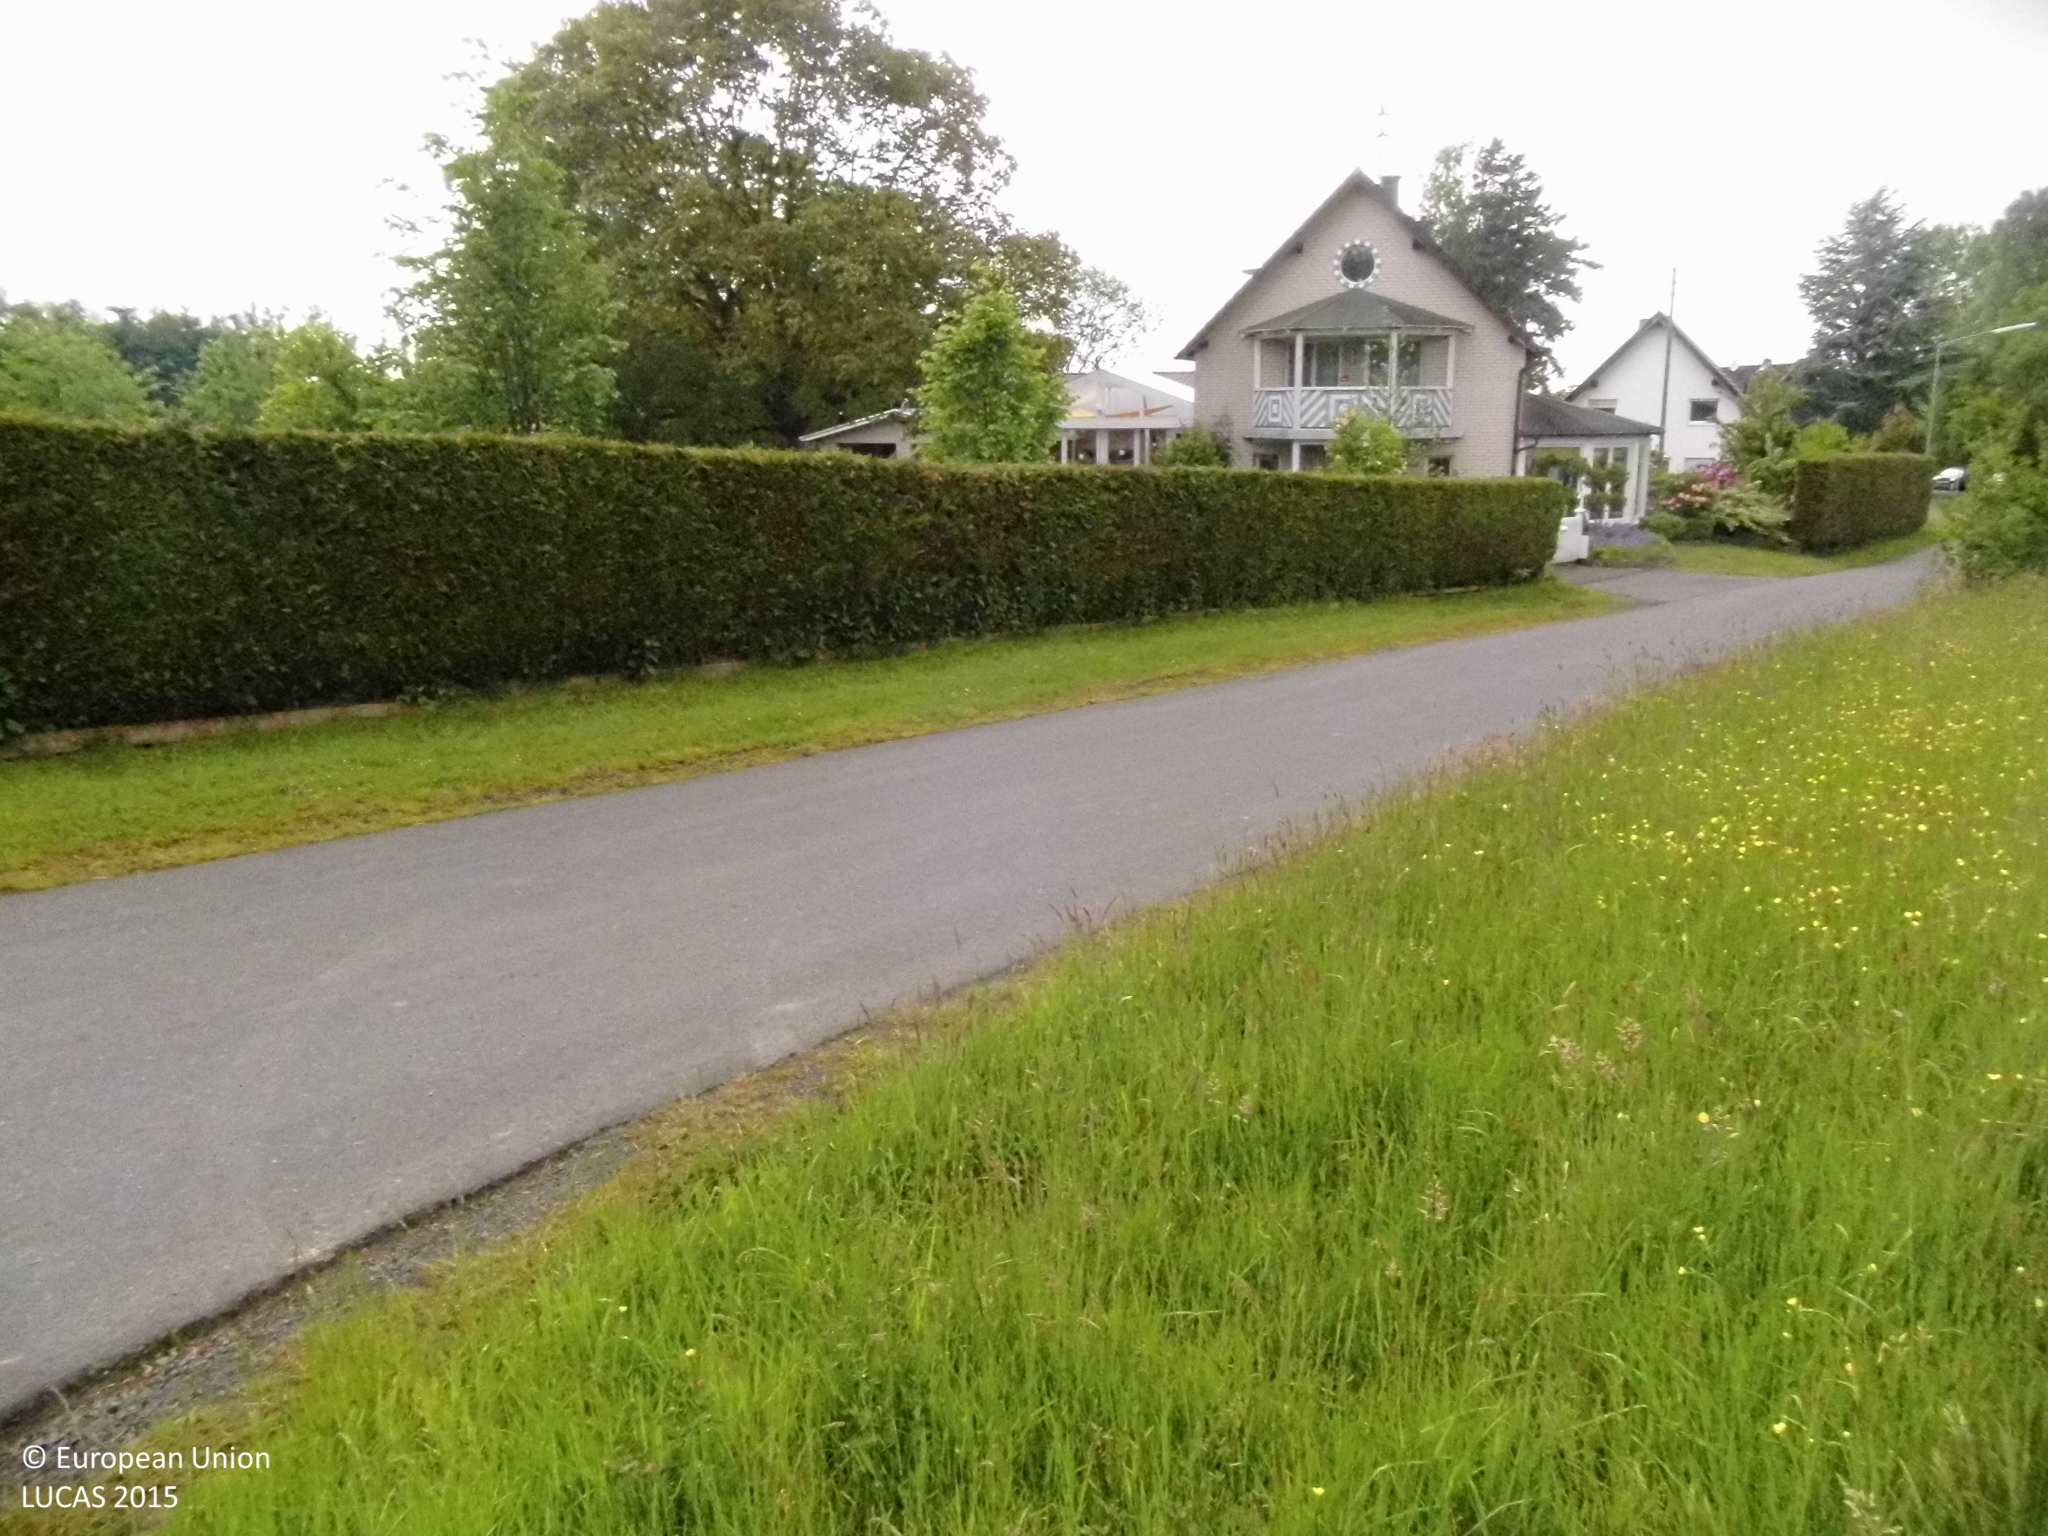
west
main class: Grassland
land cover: Grassland without tree/shrub cover
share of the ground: > 75 %
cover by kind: herbaceous plants 100 %
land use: Agriculture (excluding fallow land and kitchen gardens)
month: May
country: DE
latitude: 50.6958
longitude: 7.4661
